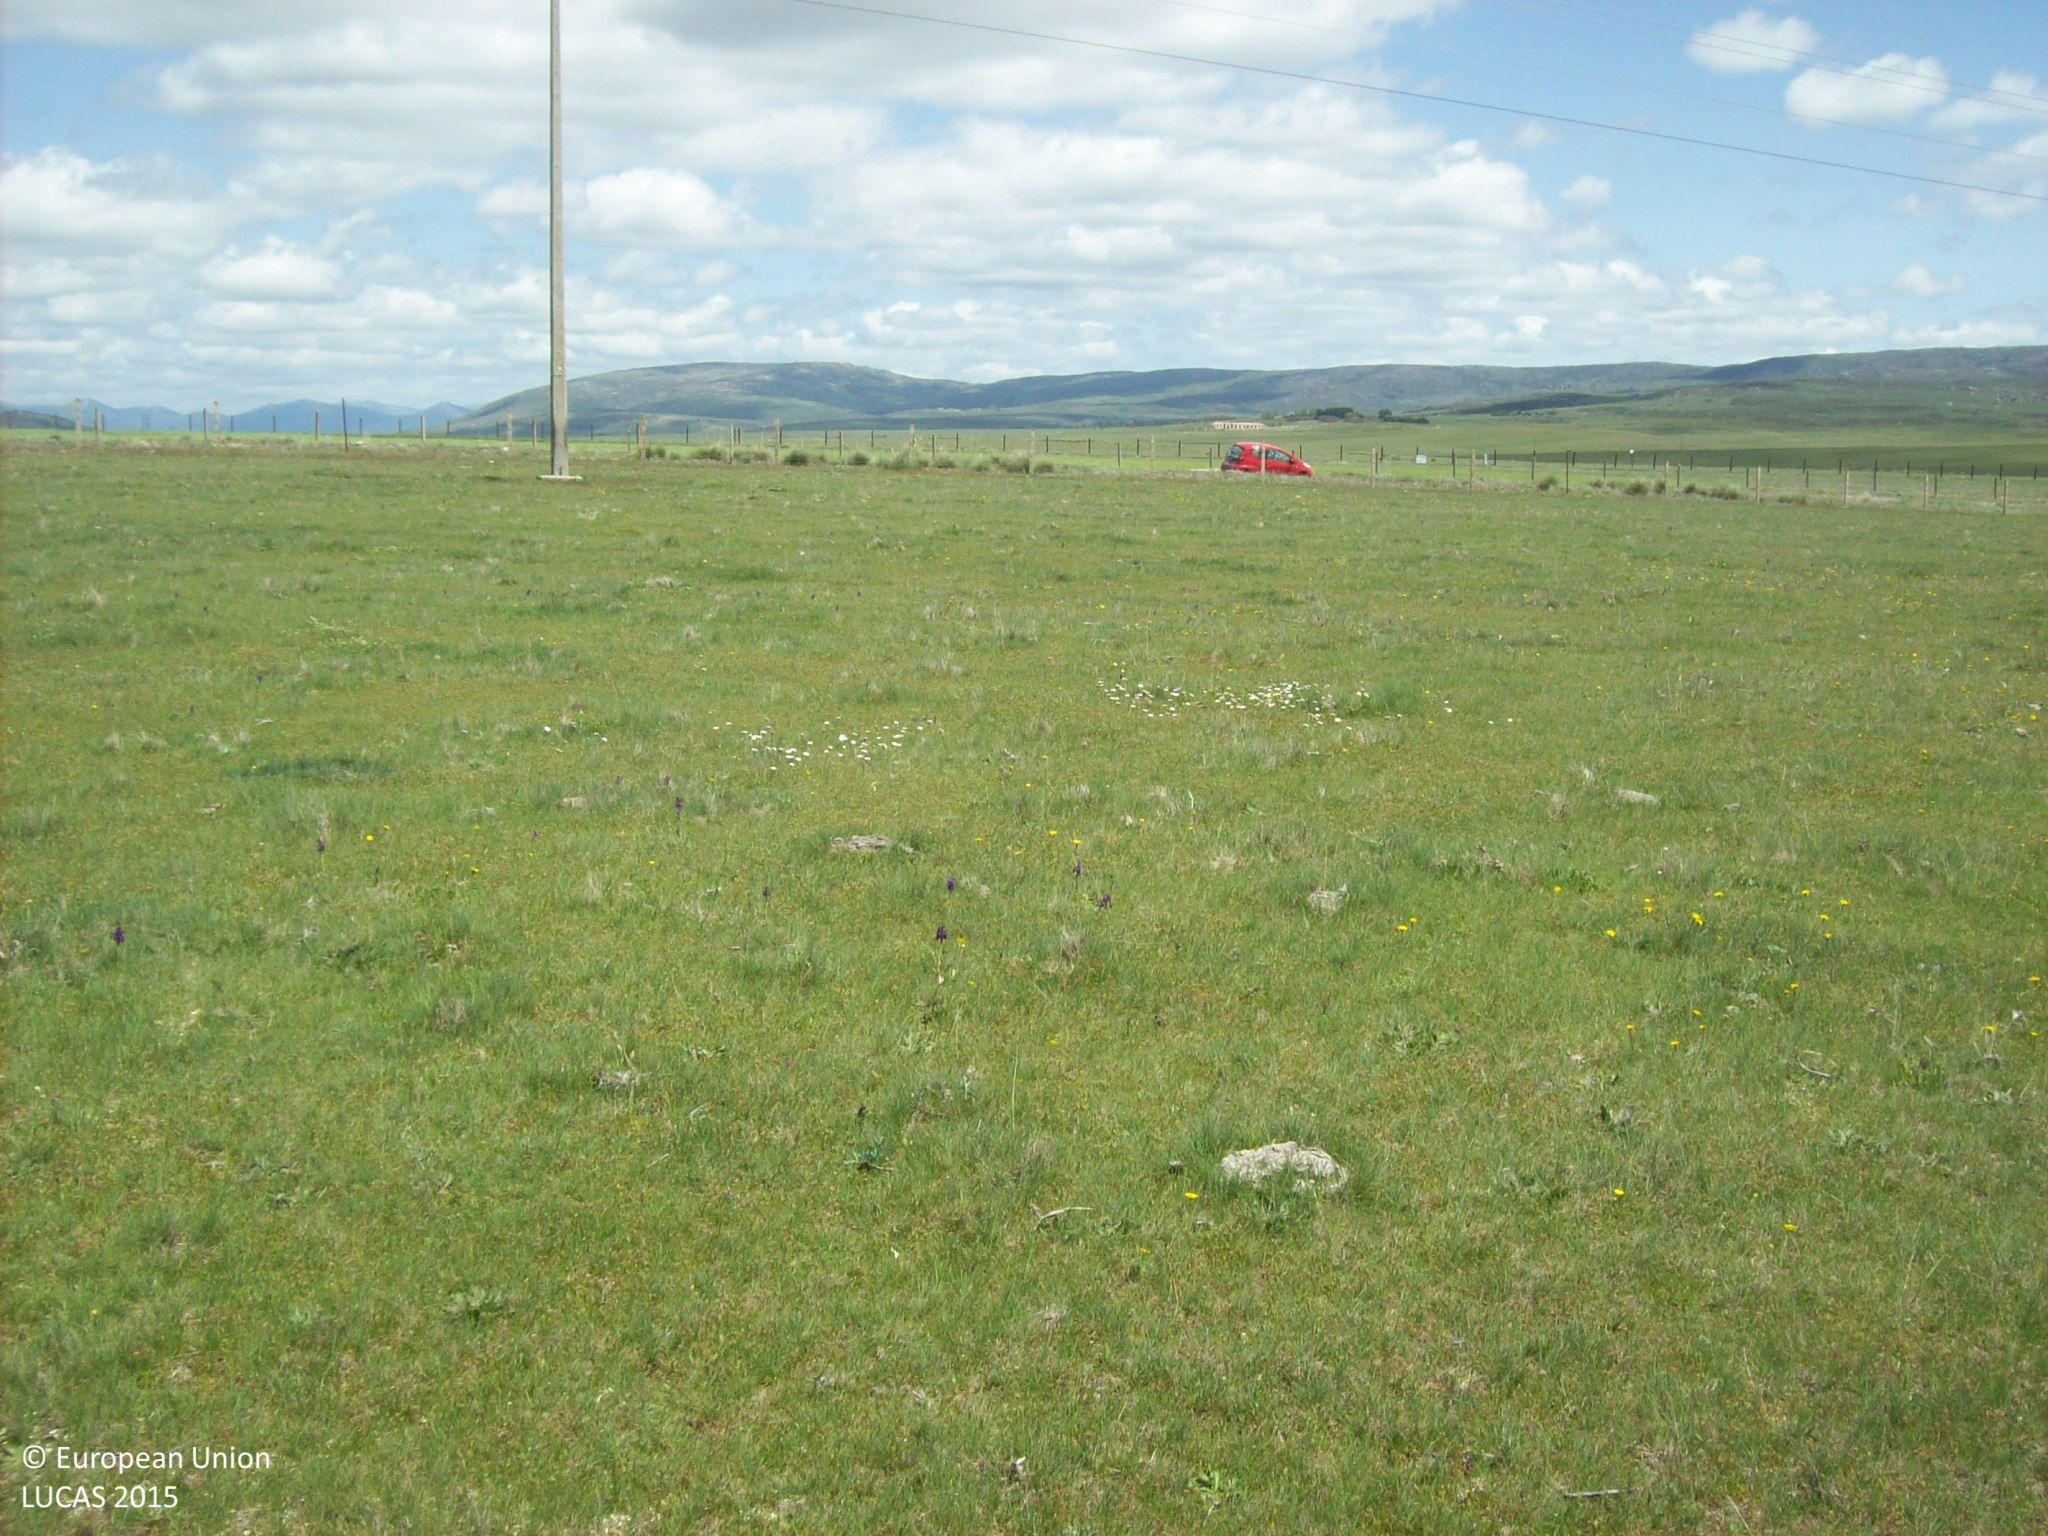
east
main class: Grassland
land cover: Grassland without tree/shrub cover
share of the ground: > 75 %
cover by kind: herbaceous plants 100 %
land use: Agriculture (excluding fallow land and kitchen gardens)
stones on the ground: < 10 %
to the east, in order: Grassland without tree/shrub cover; Electric lines; Grassland without tree/shrub cover; Fences; Grassland without tree/shrub cover; Paved roads, cycling and walking lanes; Grassland without tree/shrub cover; Fences; Common wheat; Grassland without tree/shrub cover; Fences; Grassland without tree/shrub cover
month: May
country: ES
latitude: 40.6804
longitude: -4.4268
